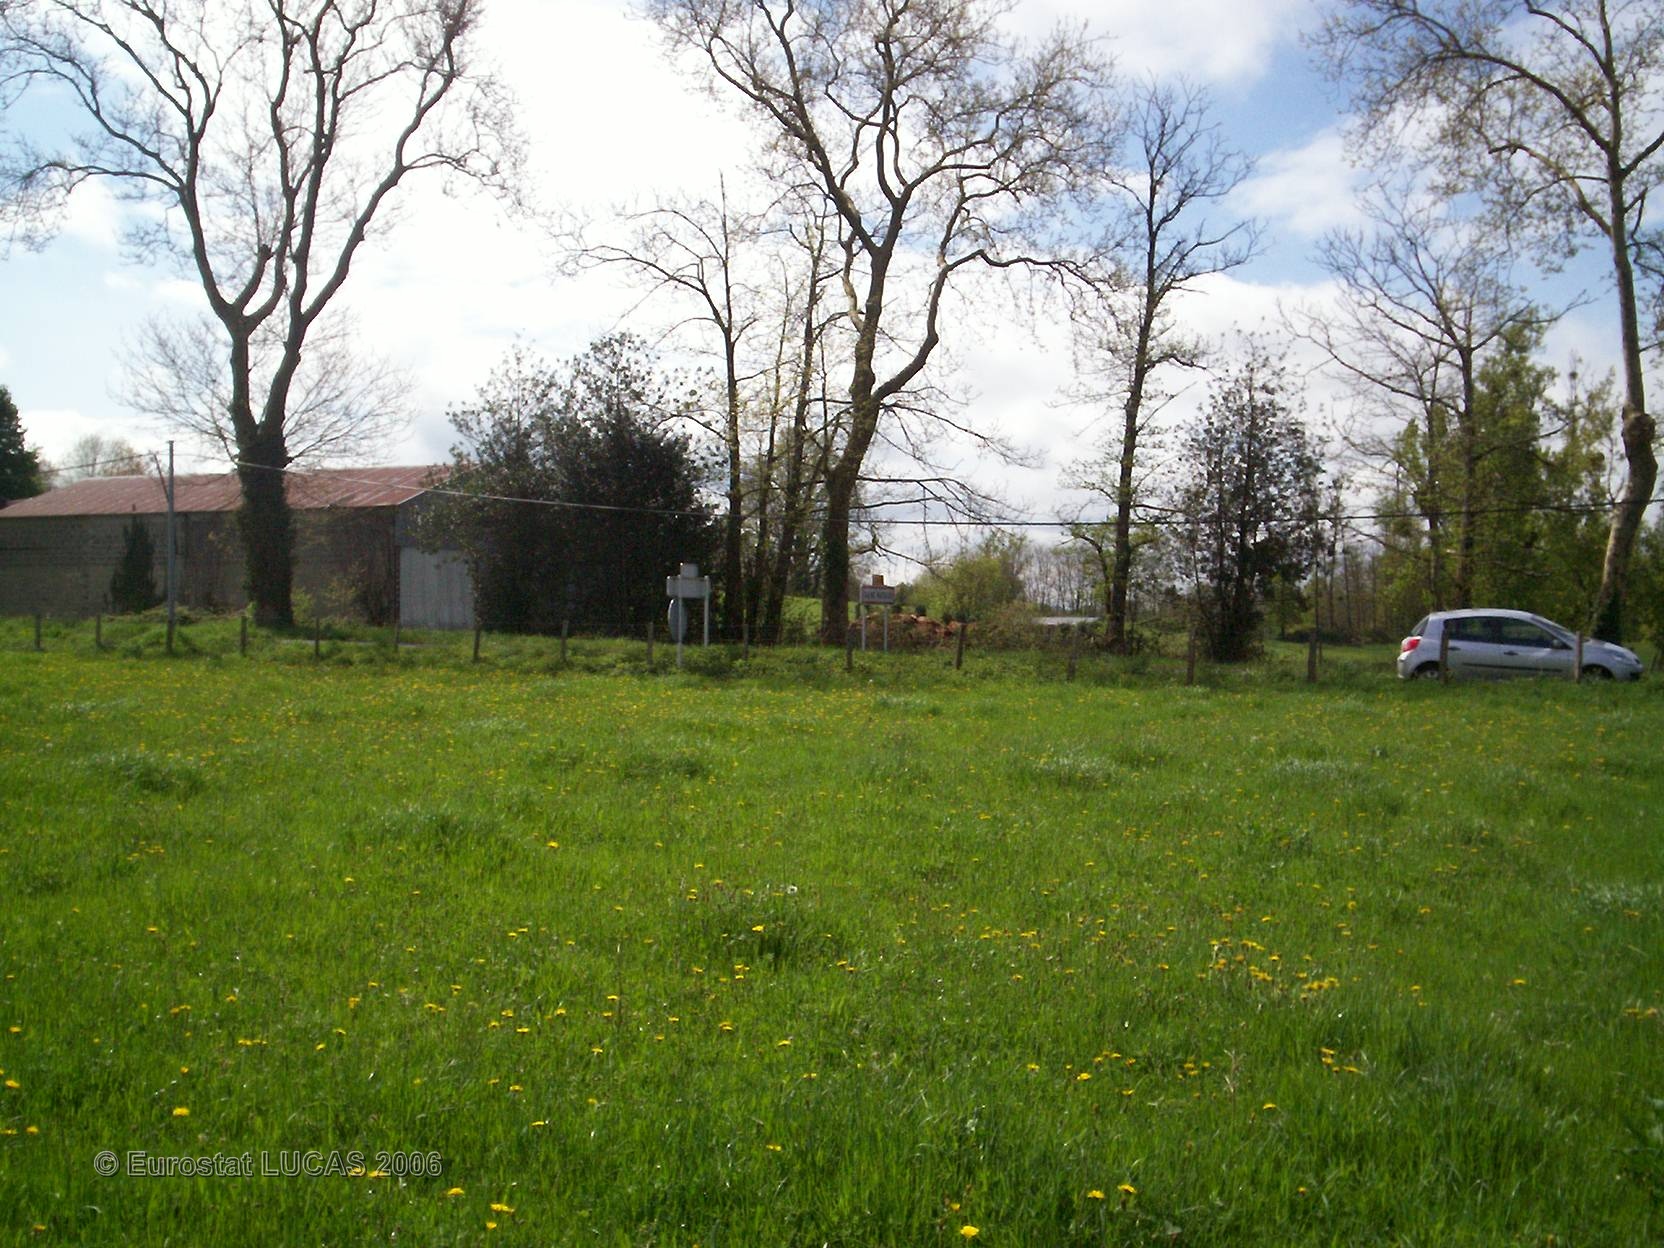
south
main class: Grassland
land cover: Grassland without tree/shrub cover
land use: Agriculture (excluding fallow land and kitchen gardens)
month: April
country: FR
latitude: 45.7141
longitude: 0.7513
